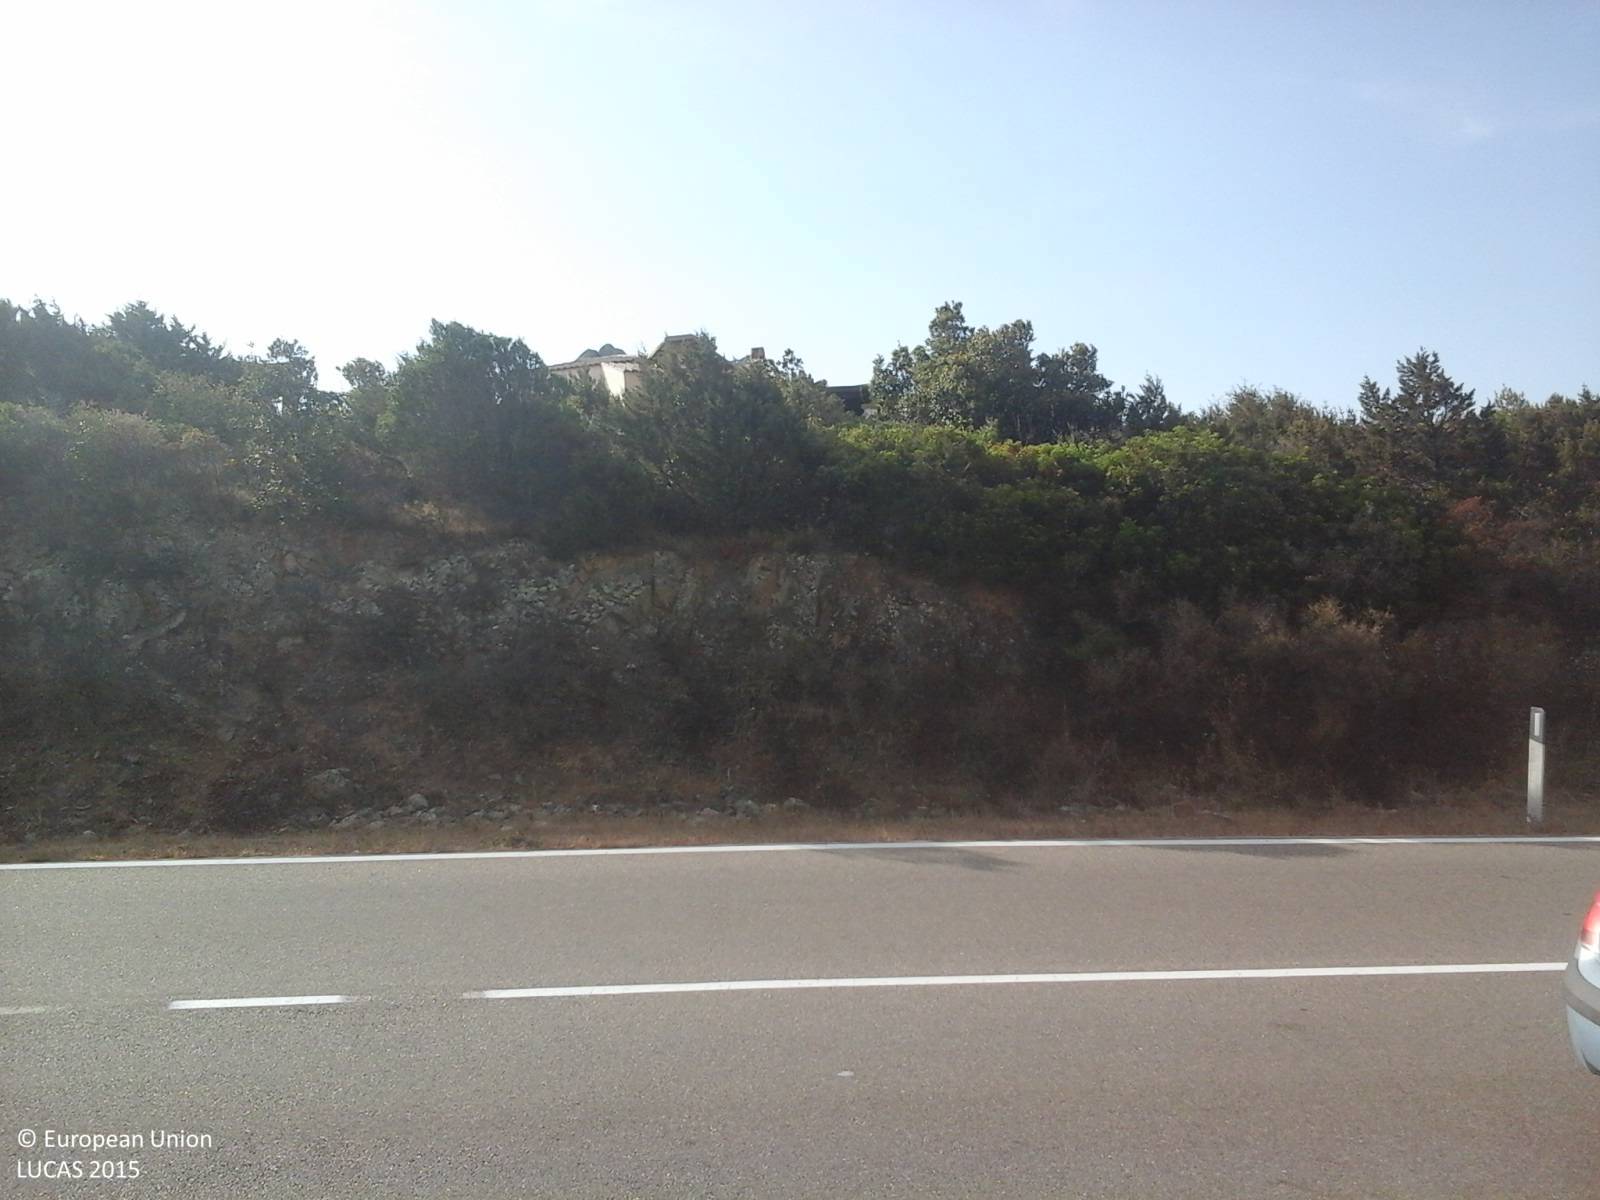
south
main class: Woodland
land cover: Broadleaved woodland
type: broadleaved evergreen forest
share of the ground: > 75 %
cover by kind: broadleaved forest trees 90 %, shrubs 5 %, unconsolidated bare surface 5 %
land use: Residential
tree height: > 5 m
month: September
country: IT
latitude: 41.1347
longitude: 9.5138
